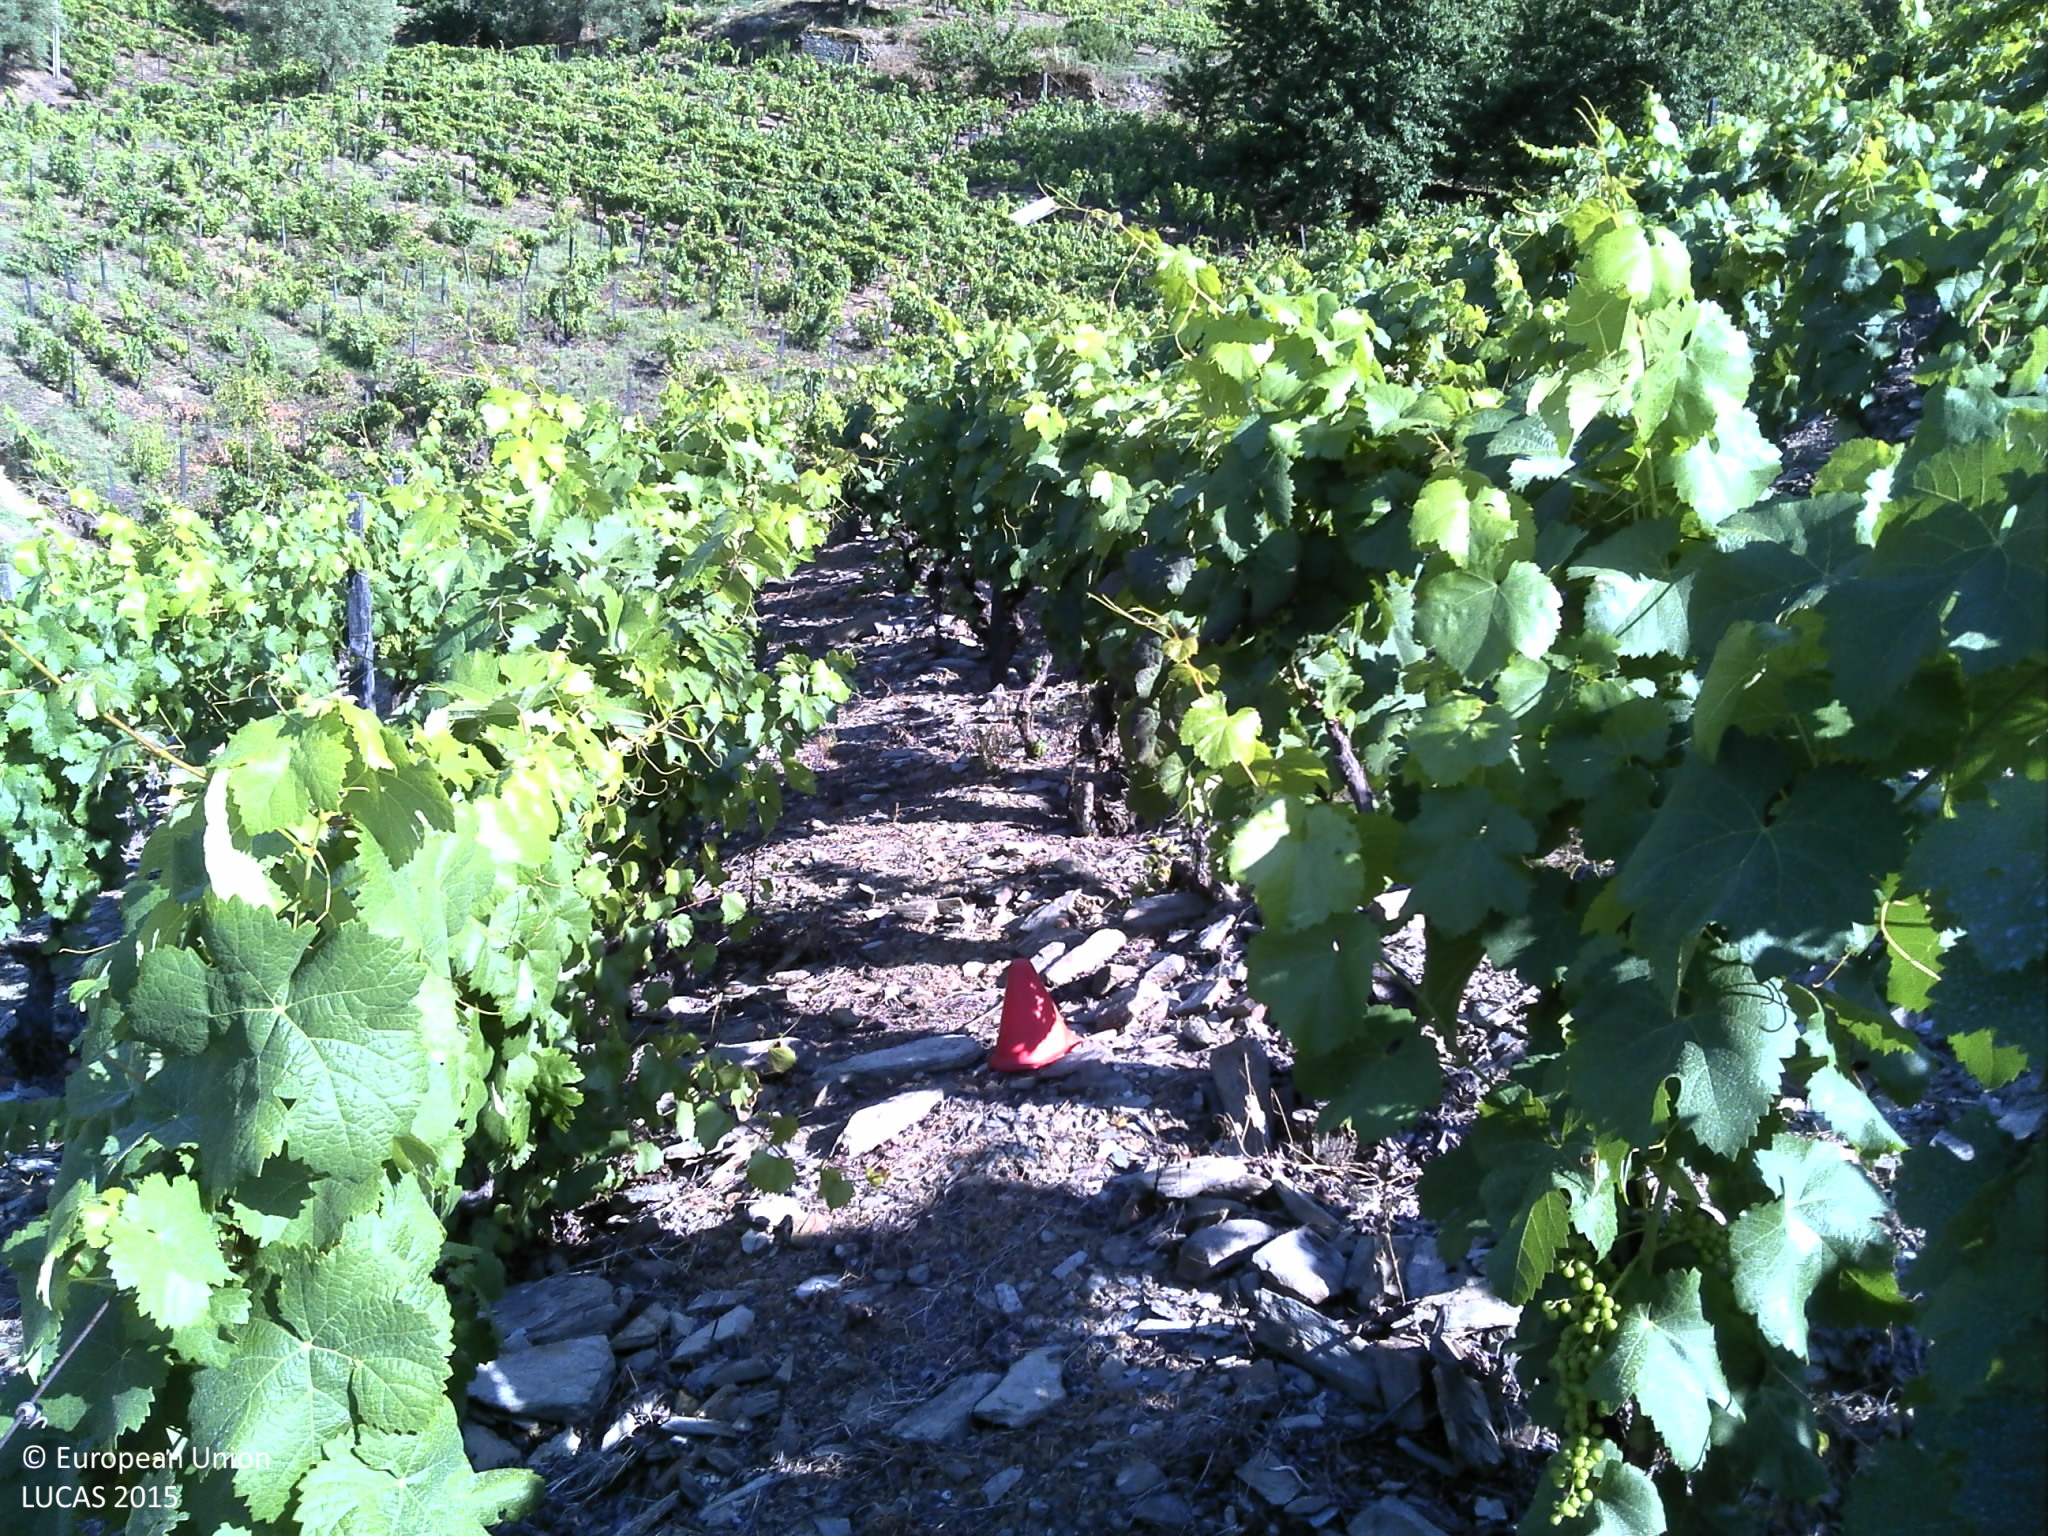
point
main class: Cropland
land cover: Vineyards
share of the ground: 10 - 25 %
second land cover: Other bare soil
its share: > 75 %
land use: Agriculture (excluding fallow land and kitchen gardens)
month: June
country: PT
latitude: 41.1403
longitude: -7.6751
